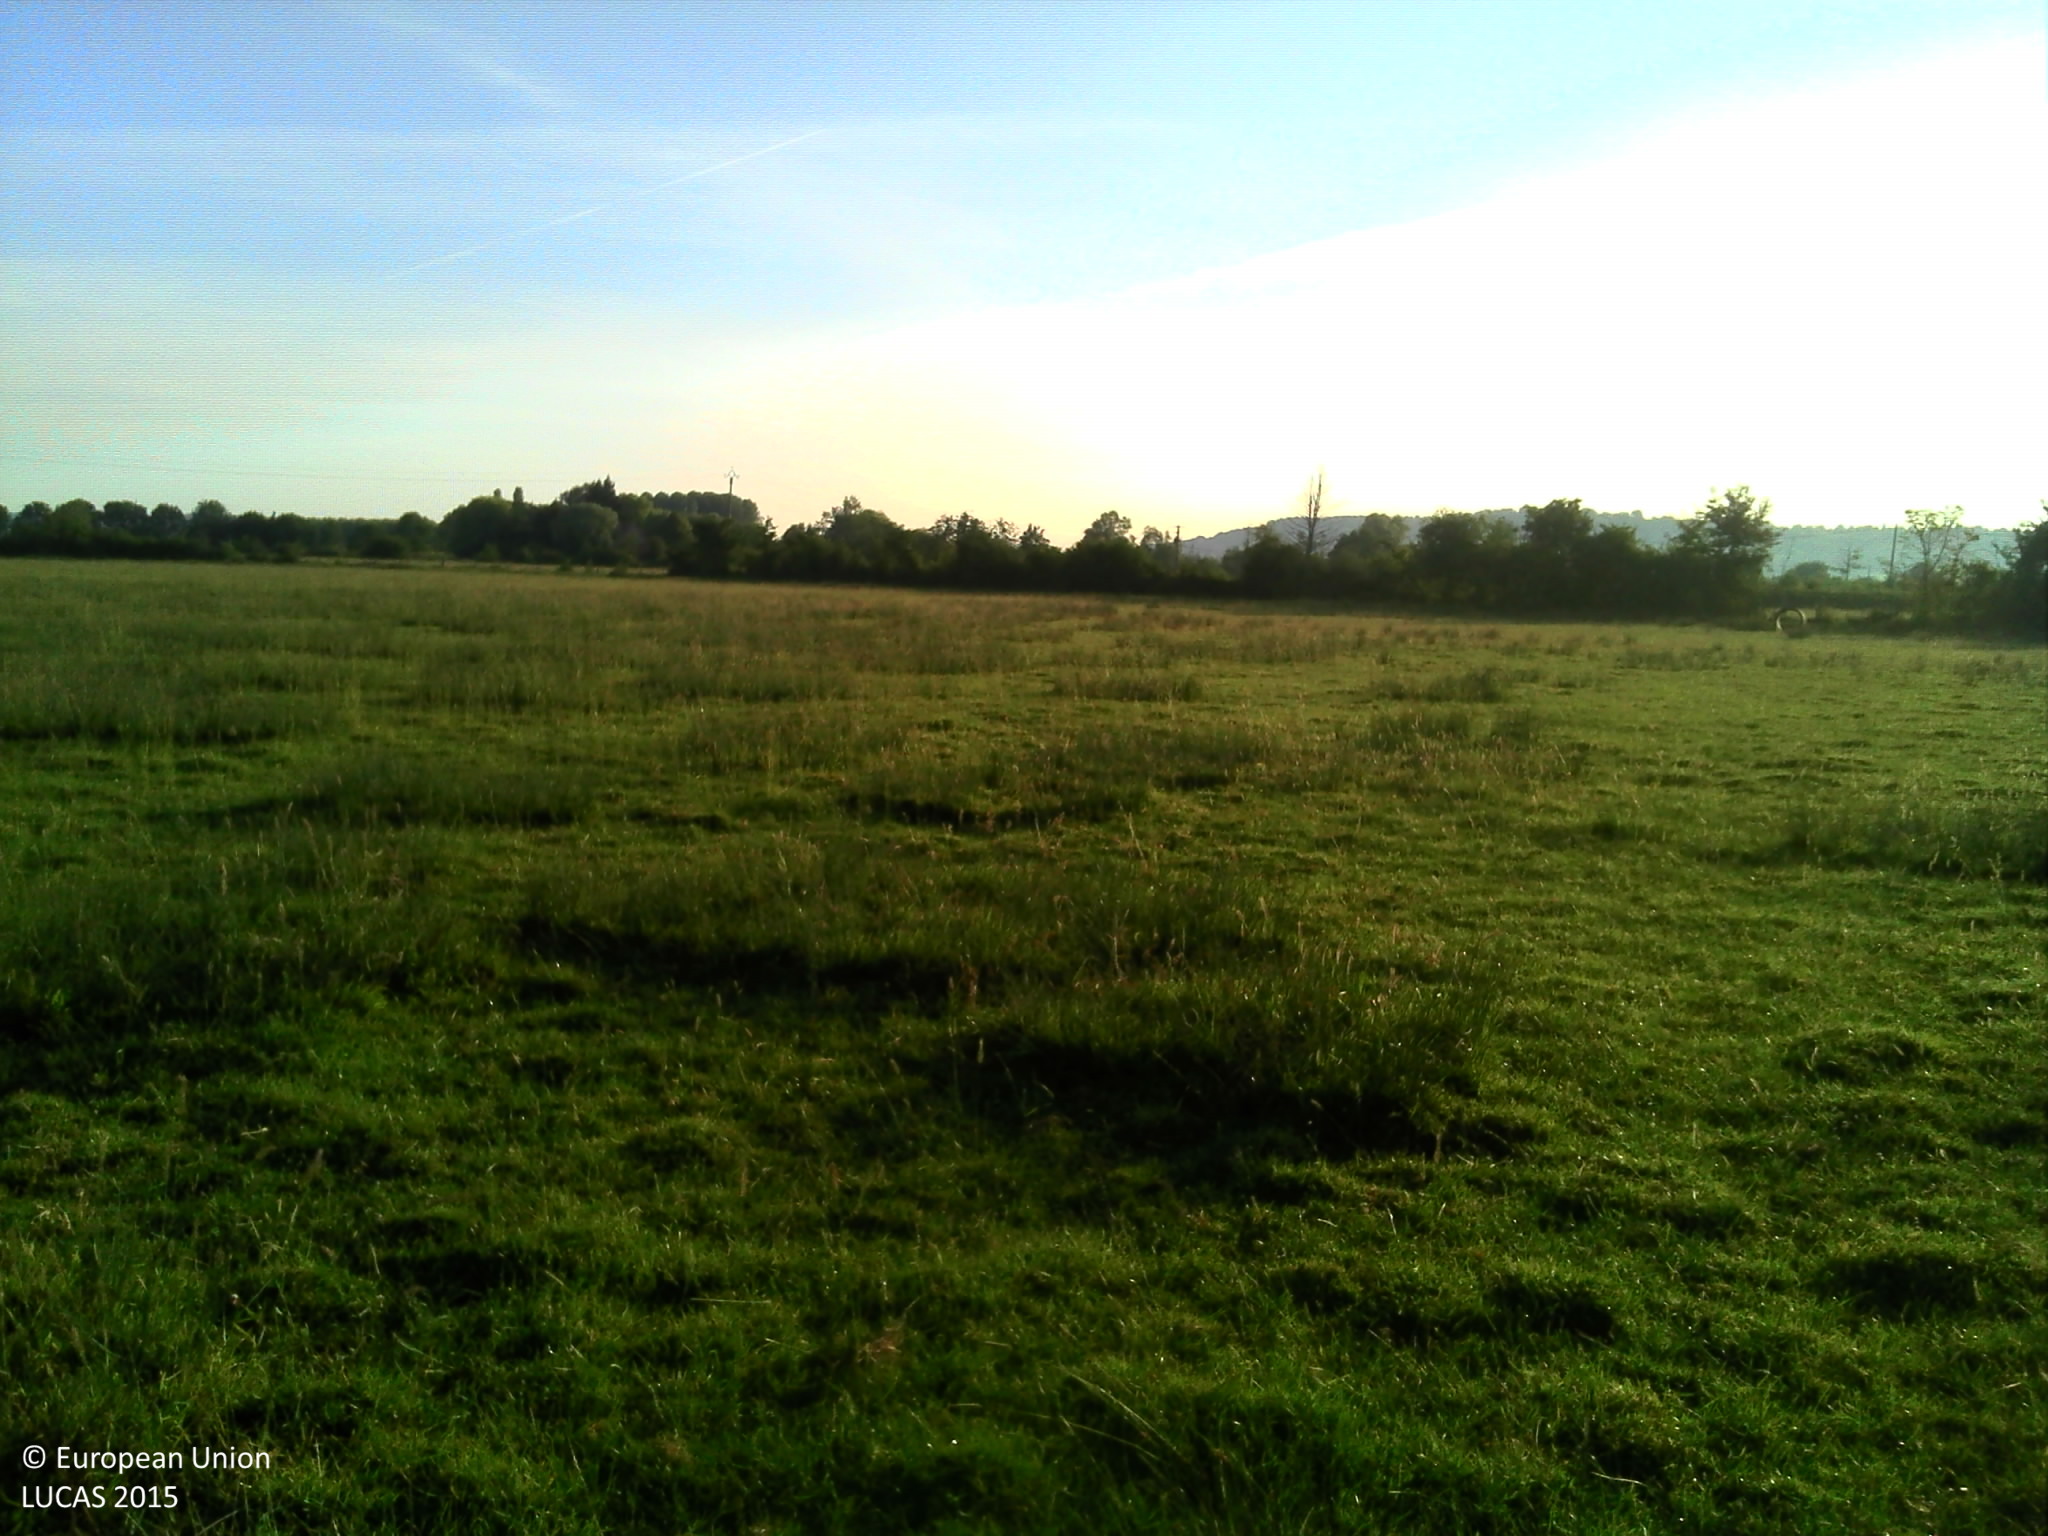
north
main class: Grassland
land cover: Grassland without tree/shrub cover
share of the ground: > 75 %
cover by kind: herbaceous plants 100 %
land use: Agriculture (excluding fallow land and kitchen gardens)
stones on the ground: < 10 %
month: June
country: FR
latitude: 49.1254
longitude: -0.0209
